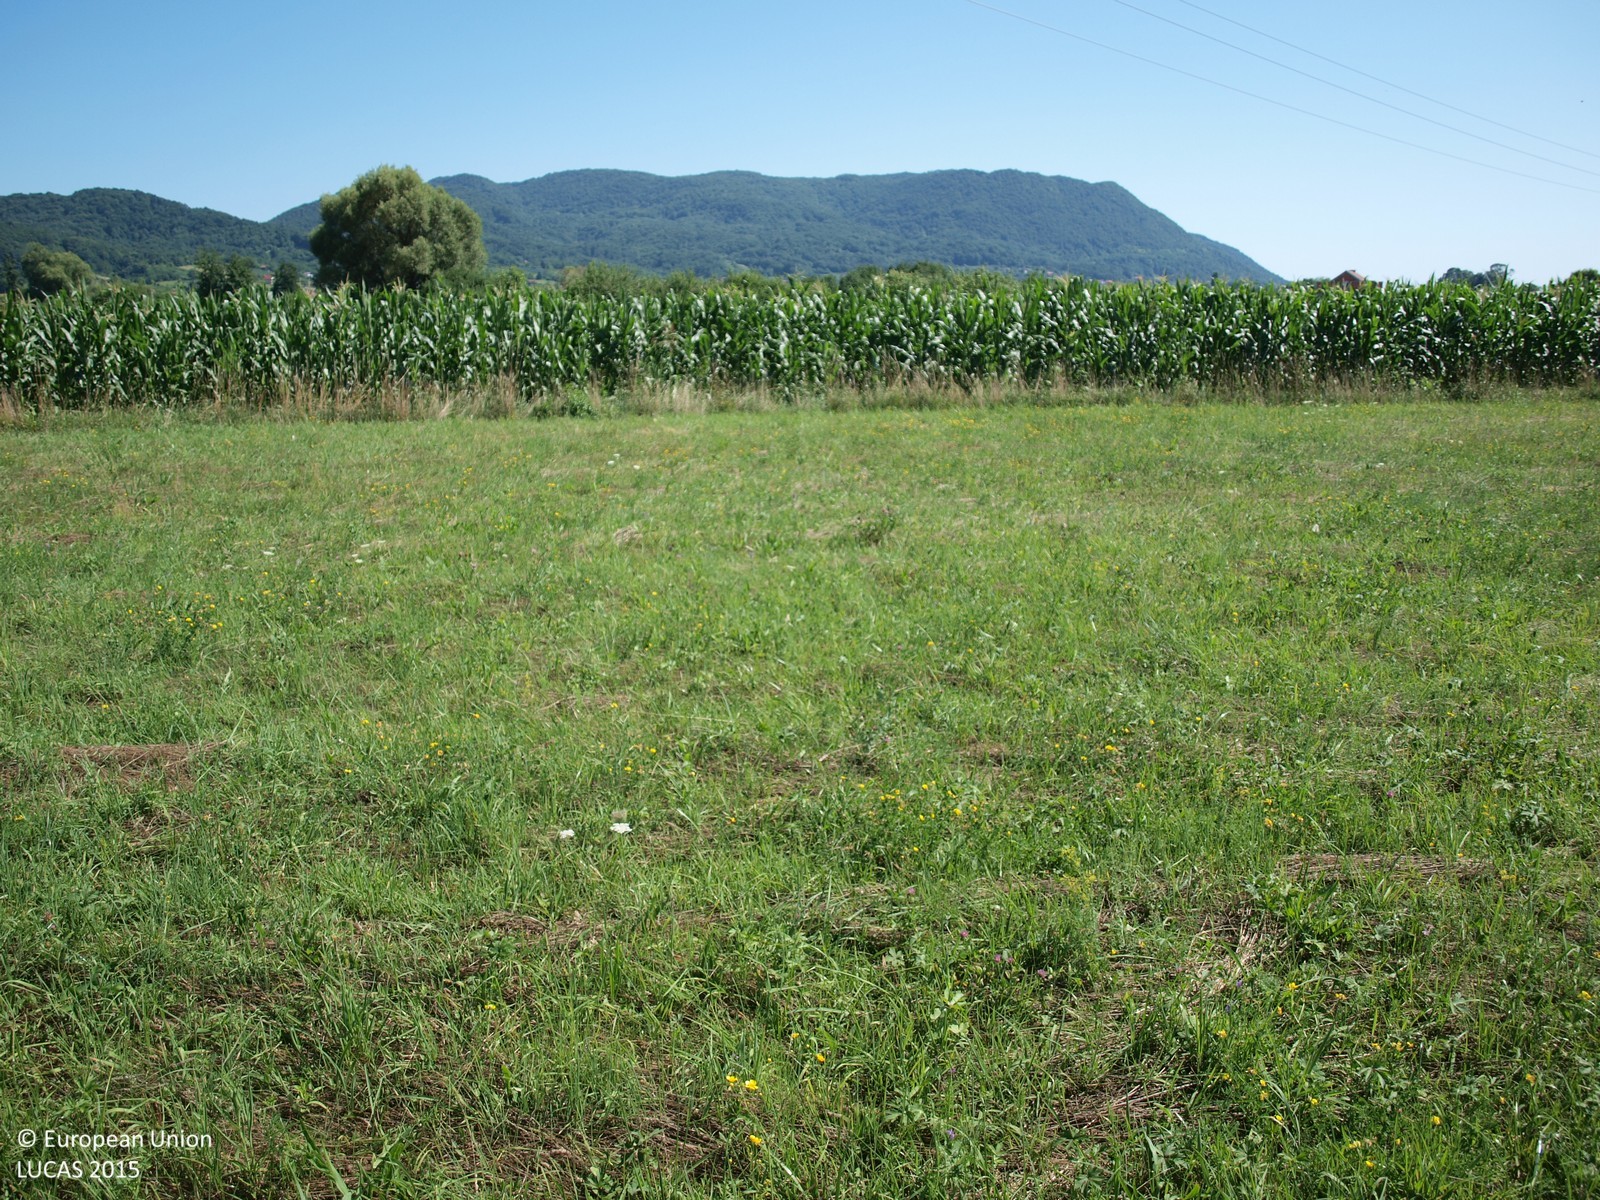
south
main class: Grassland
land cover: Grassland without tree/shrub cover
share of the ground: > 75 %
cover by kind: herbaceous plants 100 %
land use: Agriculture (excluding fallow land and kitchen gardens)
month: July
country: HR
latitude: 45.9015
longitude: 15.8626
